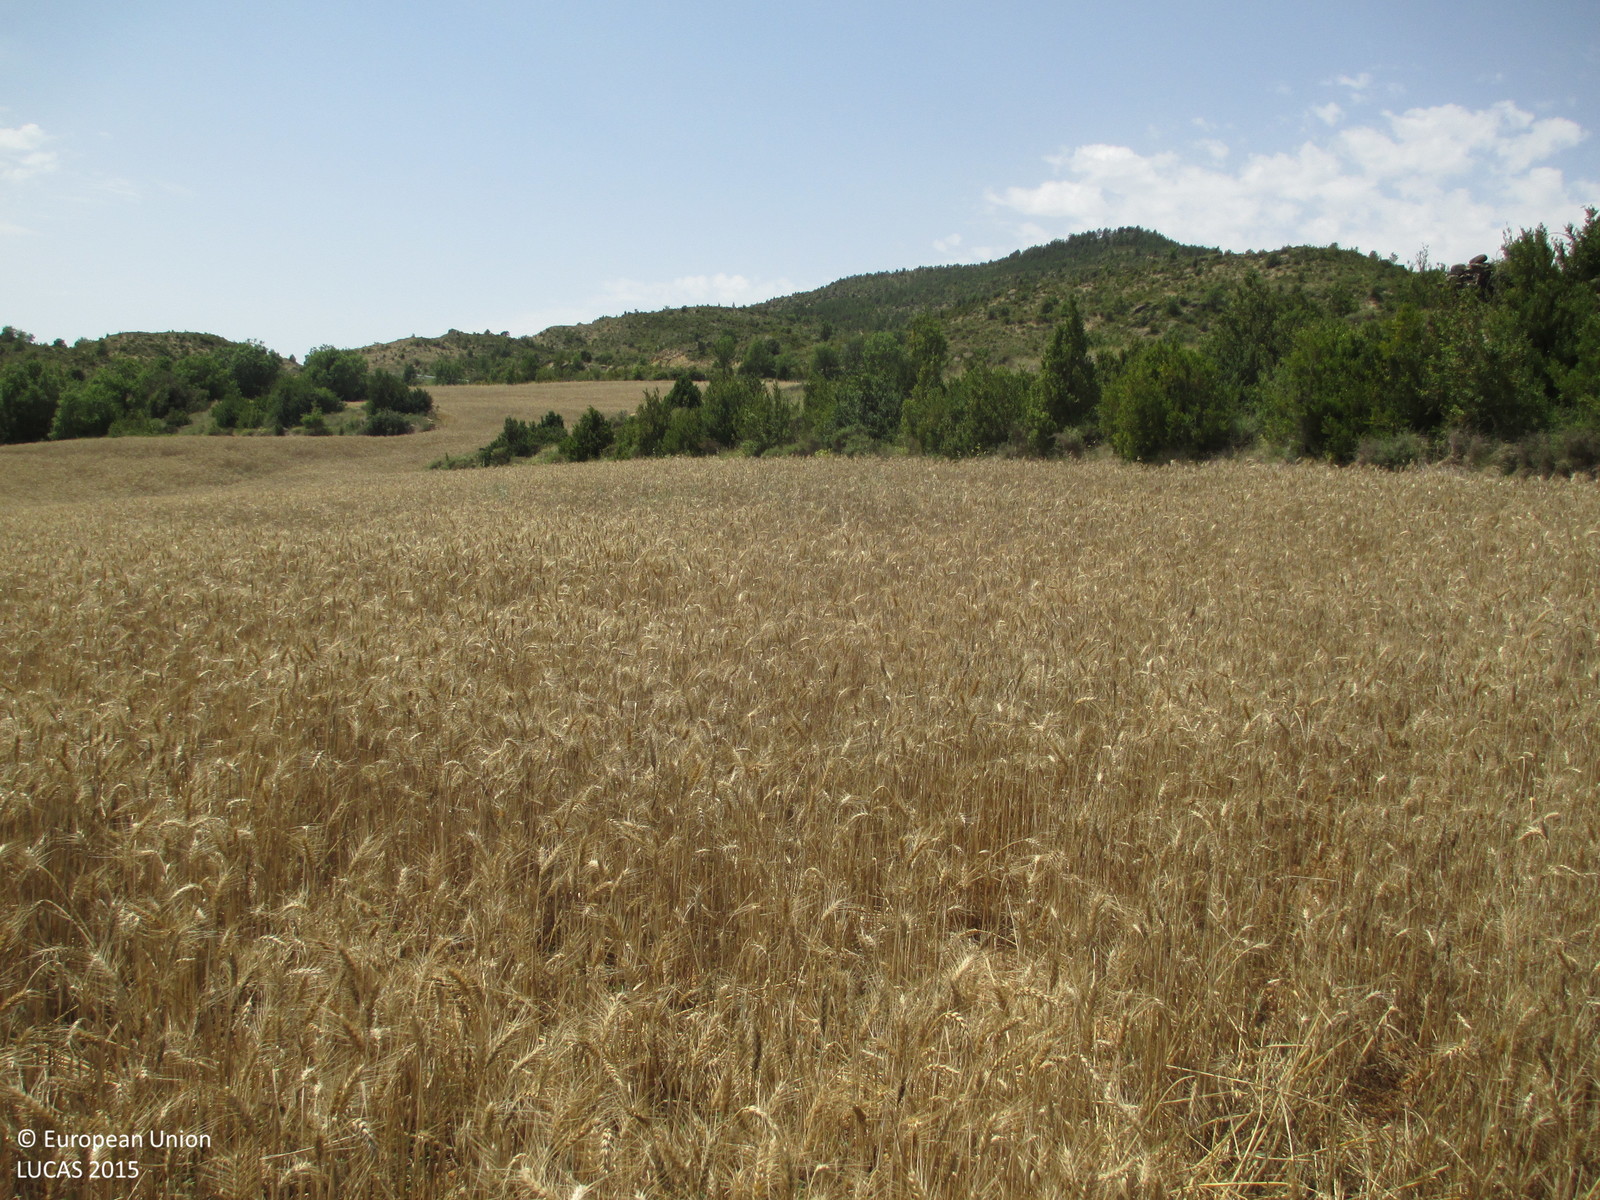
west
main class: Cropland
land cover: Common wheat
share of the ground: > 75 %
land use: Agriculture (excluding fallow land and kitchen gardens)
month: July
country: ES
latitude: 42.4198
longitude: -0.4647
